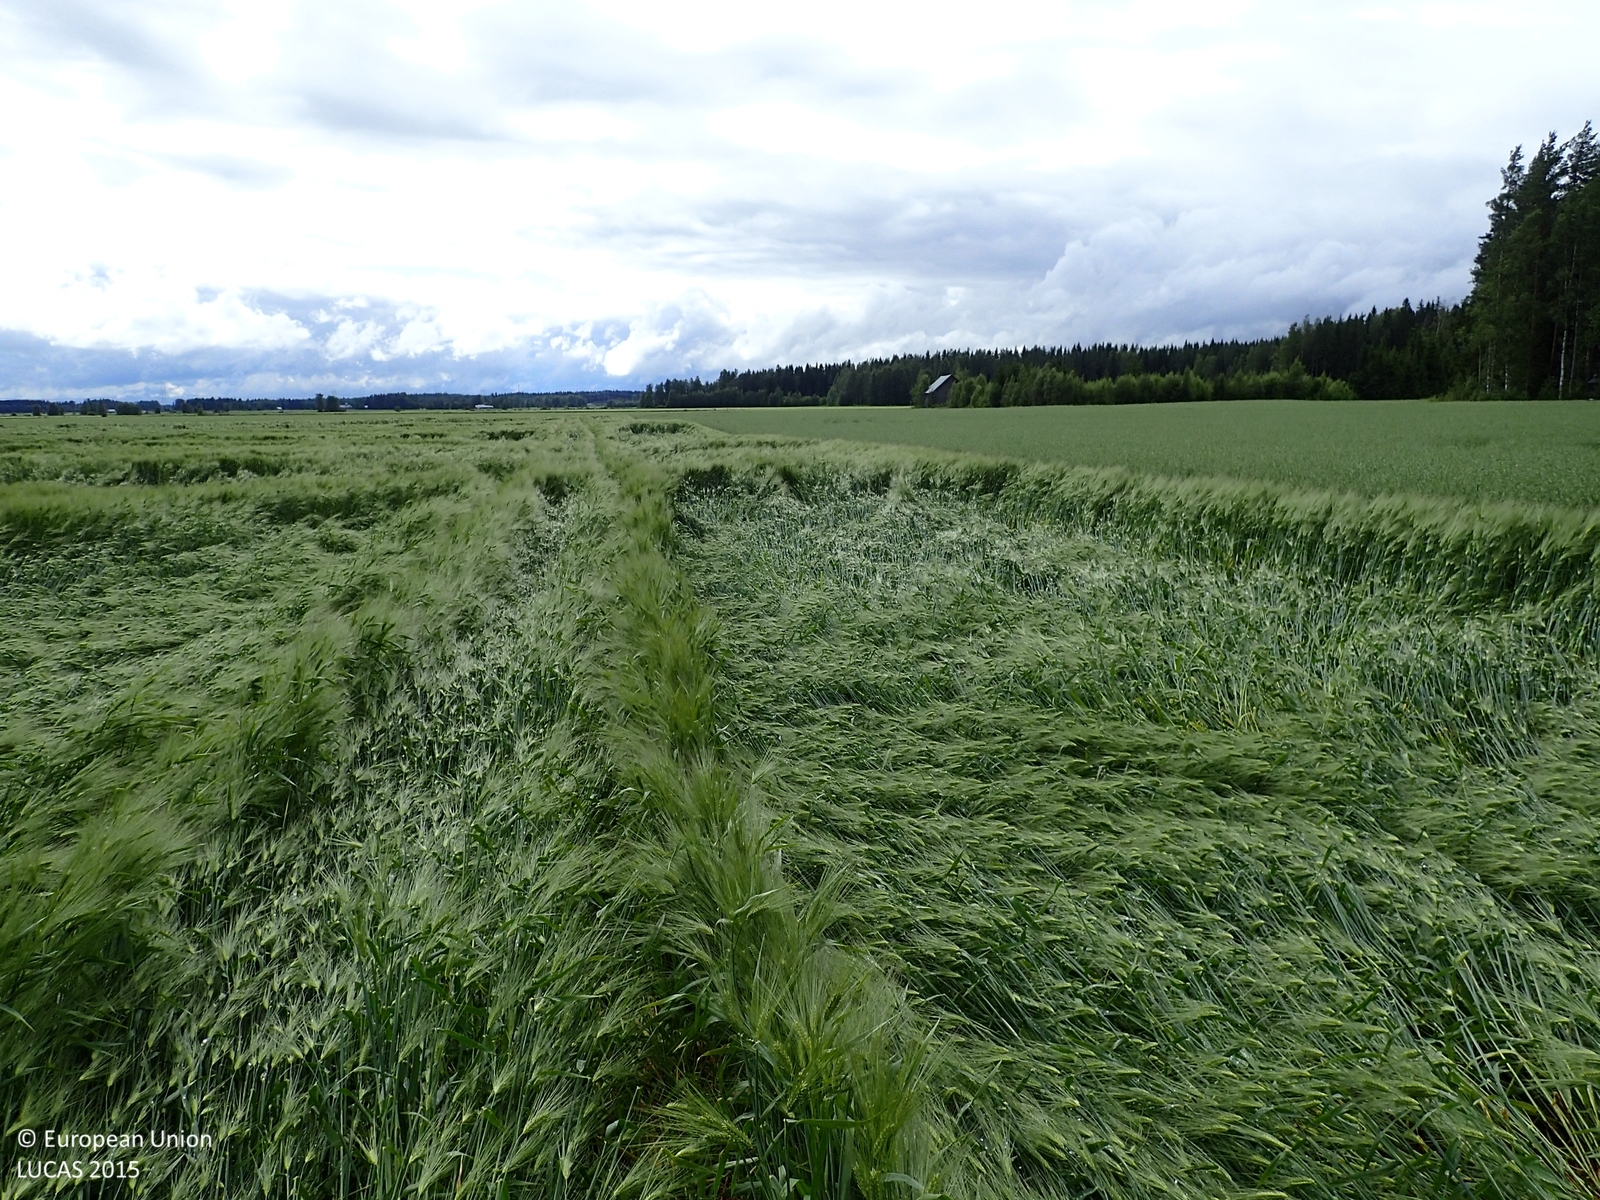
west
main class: Cropland
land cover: Oats
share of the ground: > 75 %
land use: Agriculture (excluding fallow land and kitchen gardens)
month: July
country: FI
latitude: 62.8248
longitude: 22.6751
